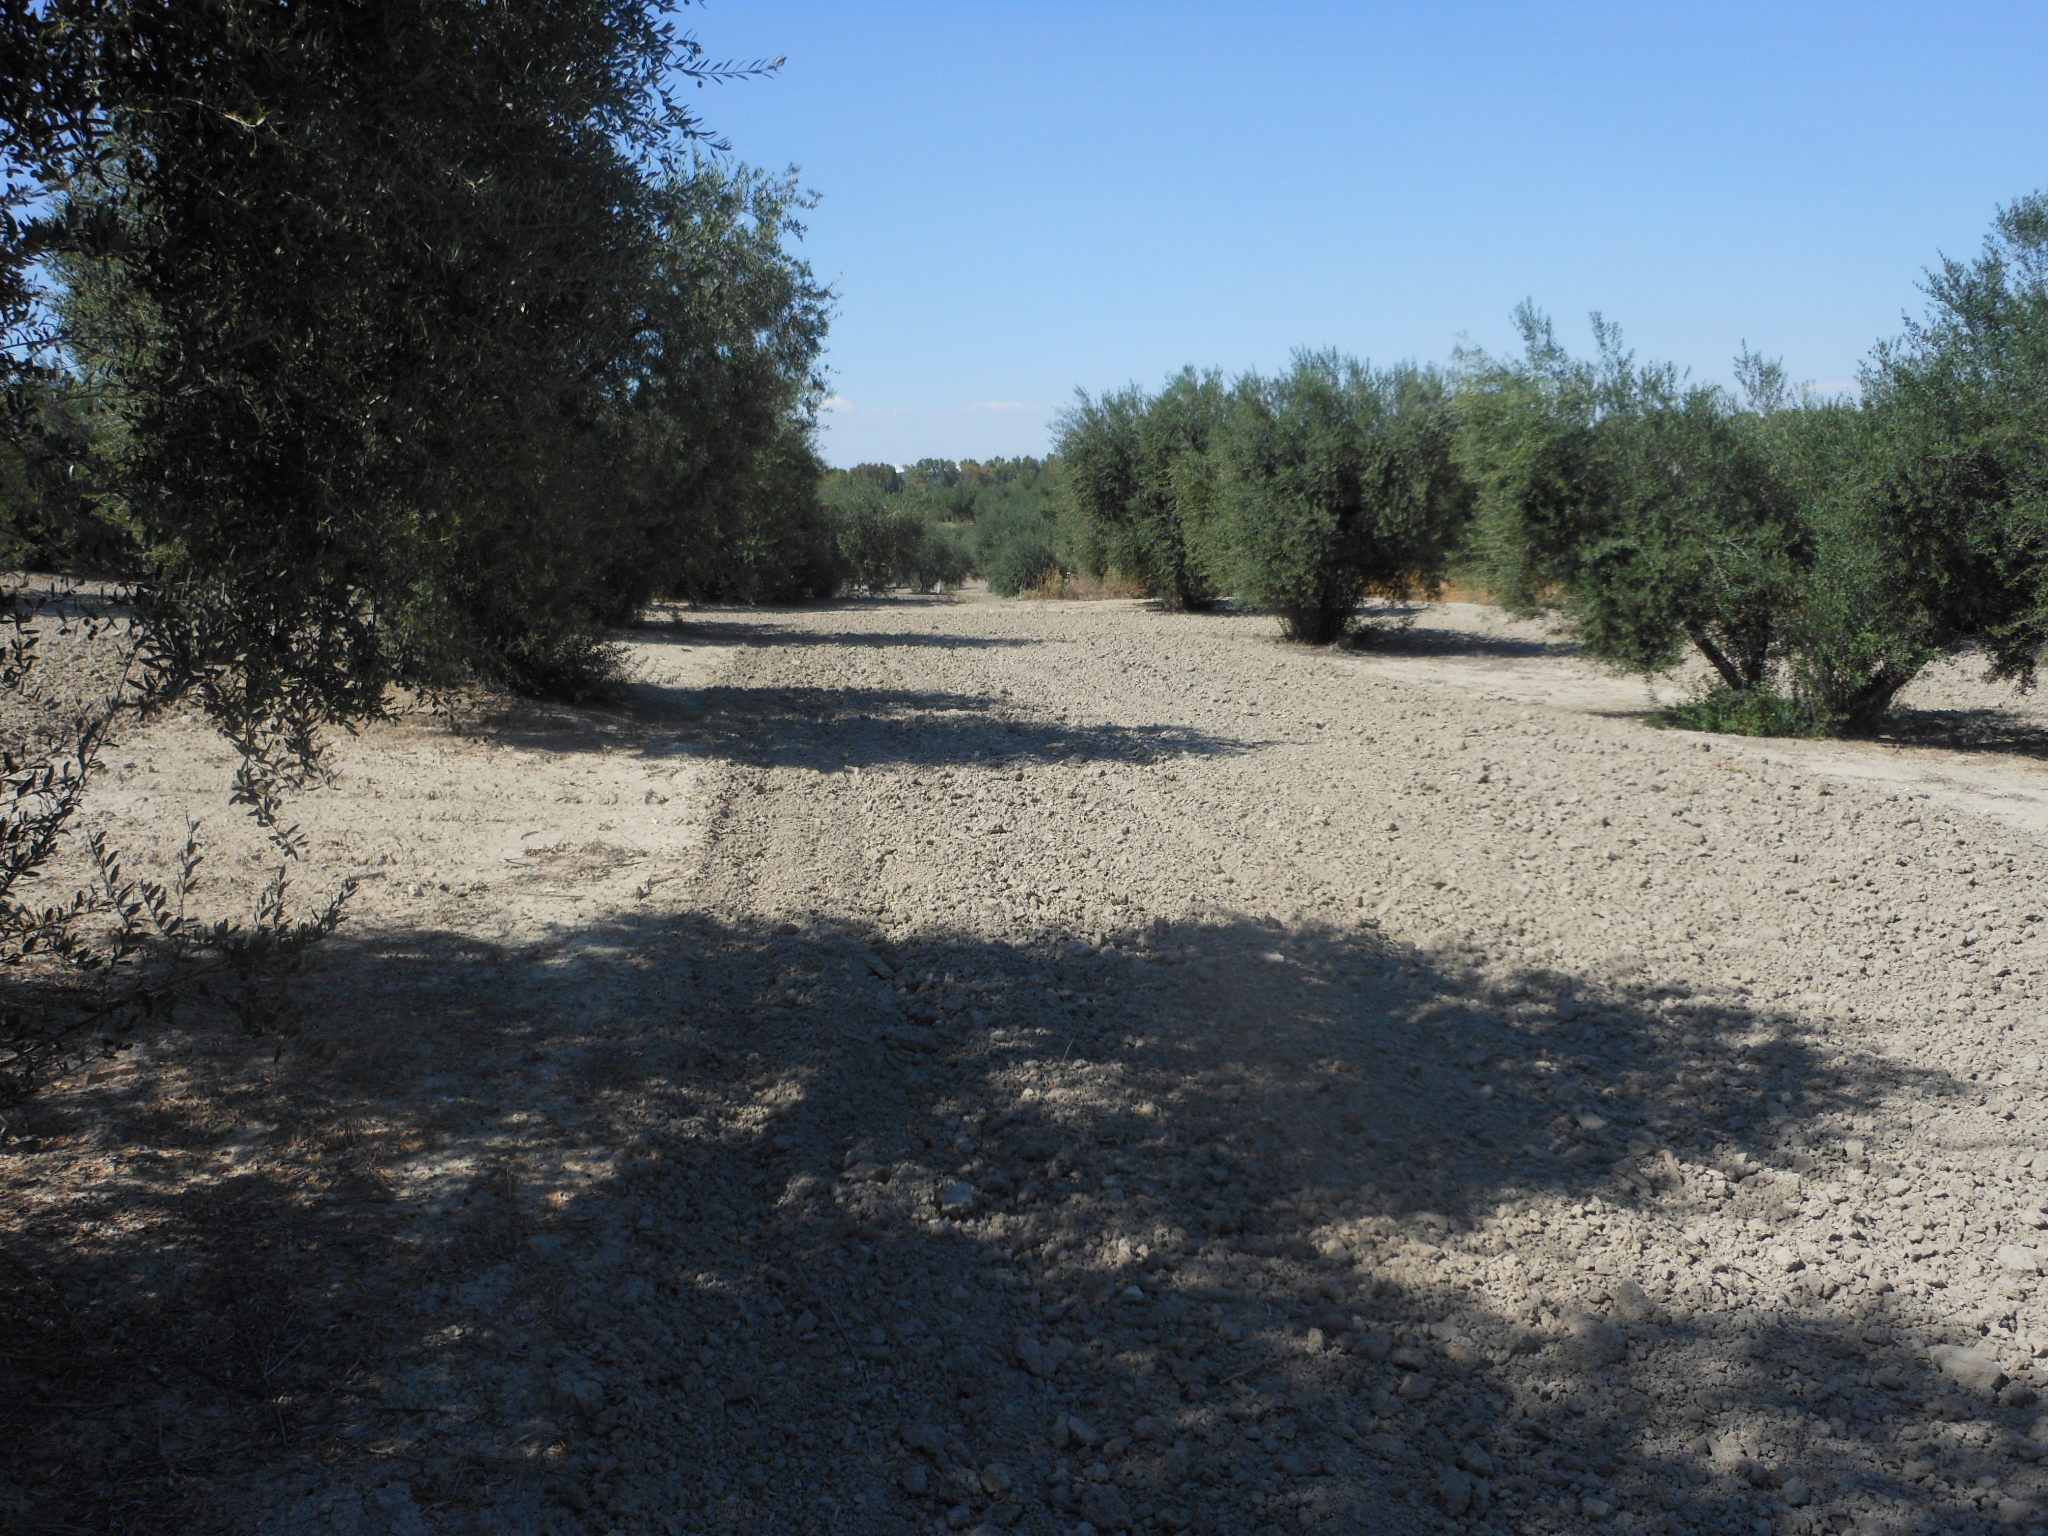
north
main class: Cropland
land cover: Olive groves
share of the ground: 25 - 50 %
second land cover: Other bare soil
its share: > 75 %
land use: Agriculture (excluding fallow land and kitchen gardens)
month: June
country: ES
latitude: 37.2148
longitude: -5.5532
